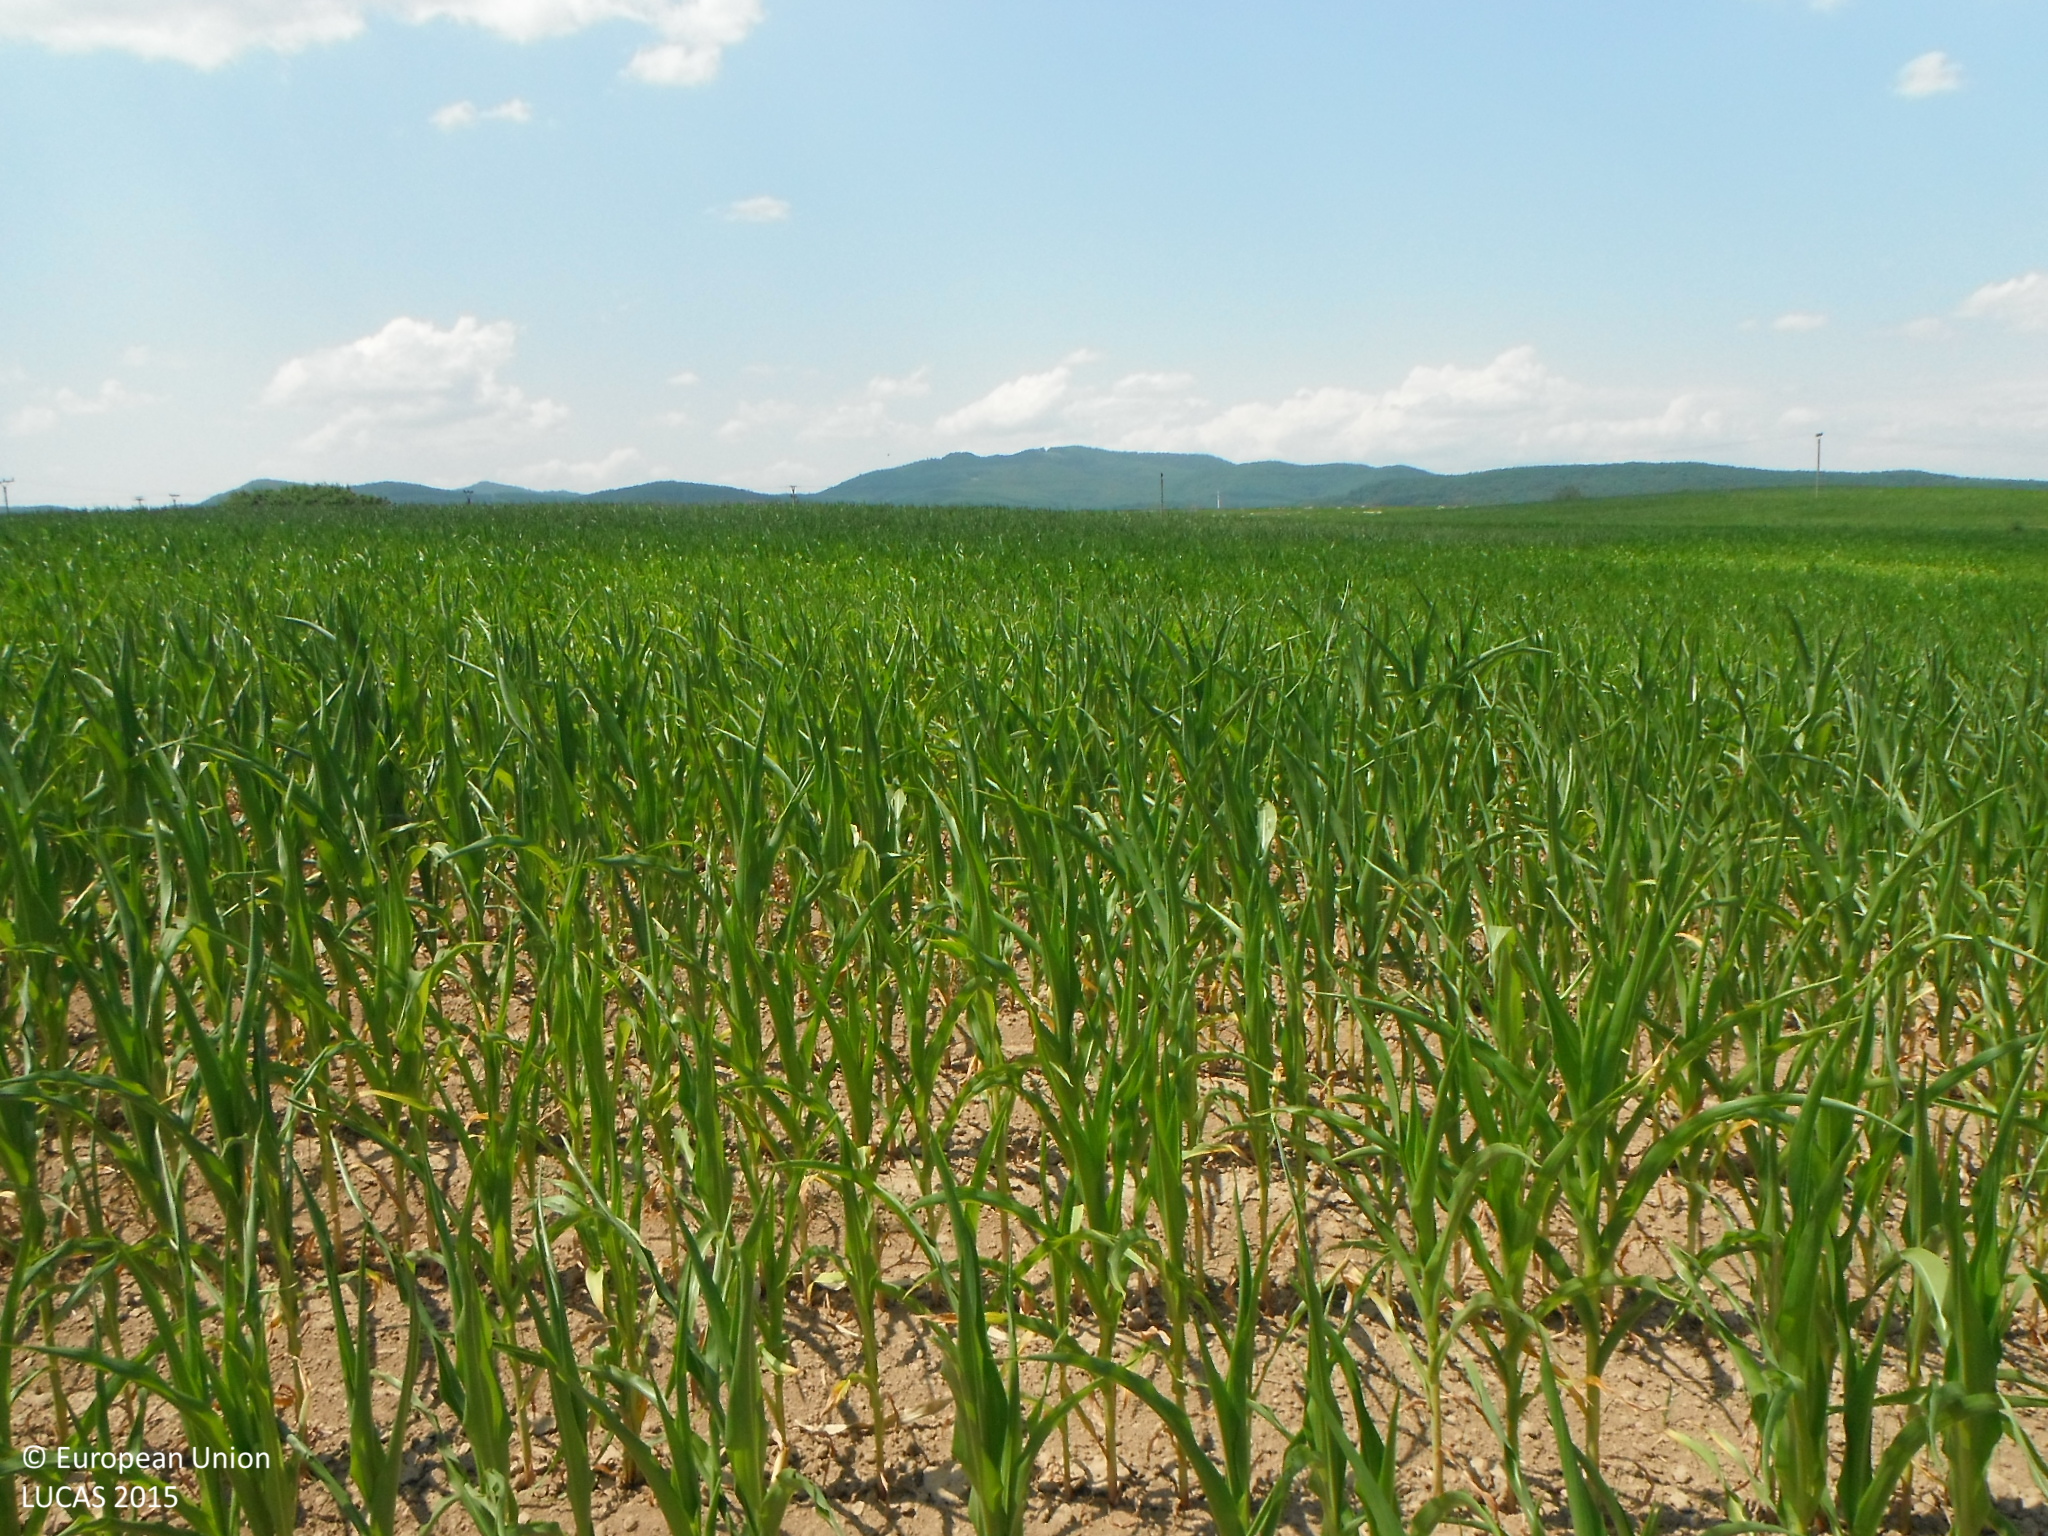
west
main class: Cropland
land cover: Maize
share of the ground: 50 - 75 %
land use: Agriculture (excluding fallow land and kitchen gardens)
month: July
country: SK
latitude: 48.4803
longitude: 19.0989
